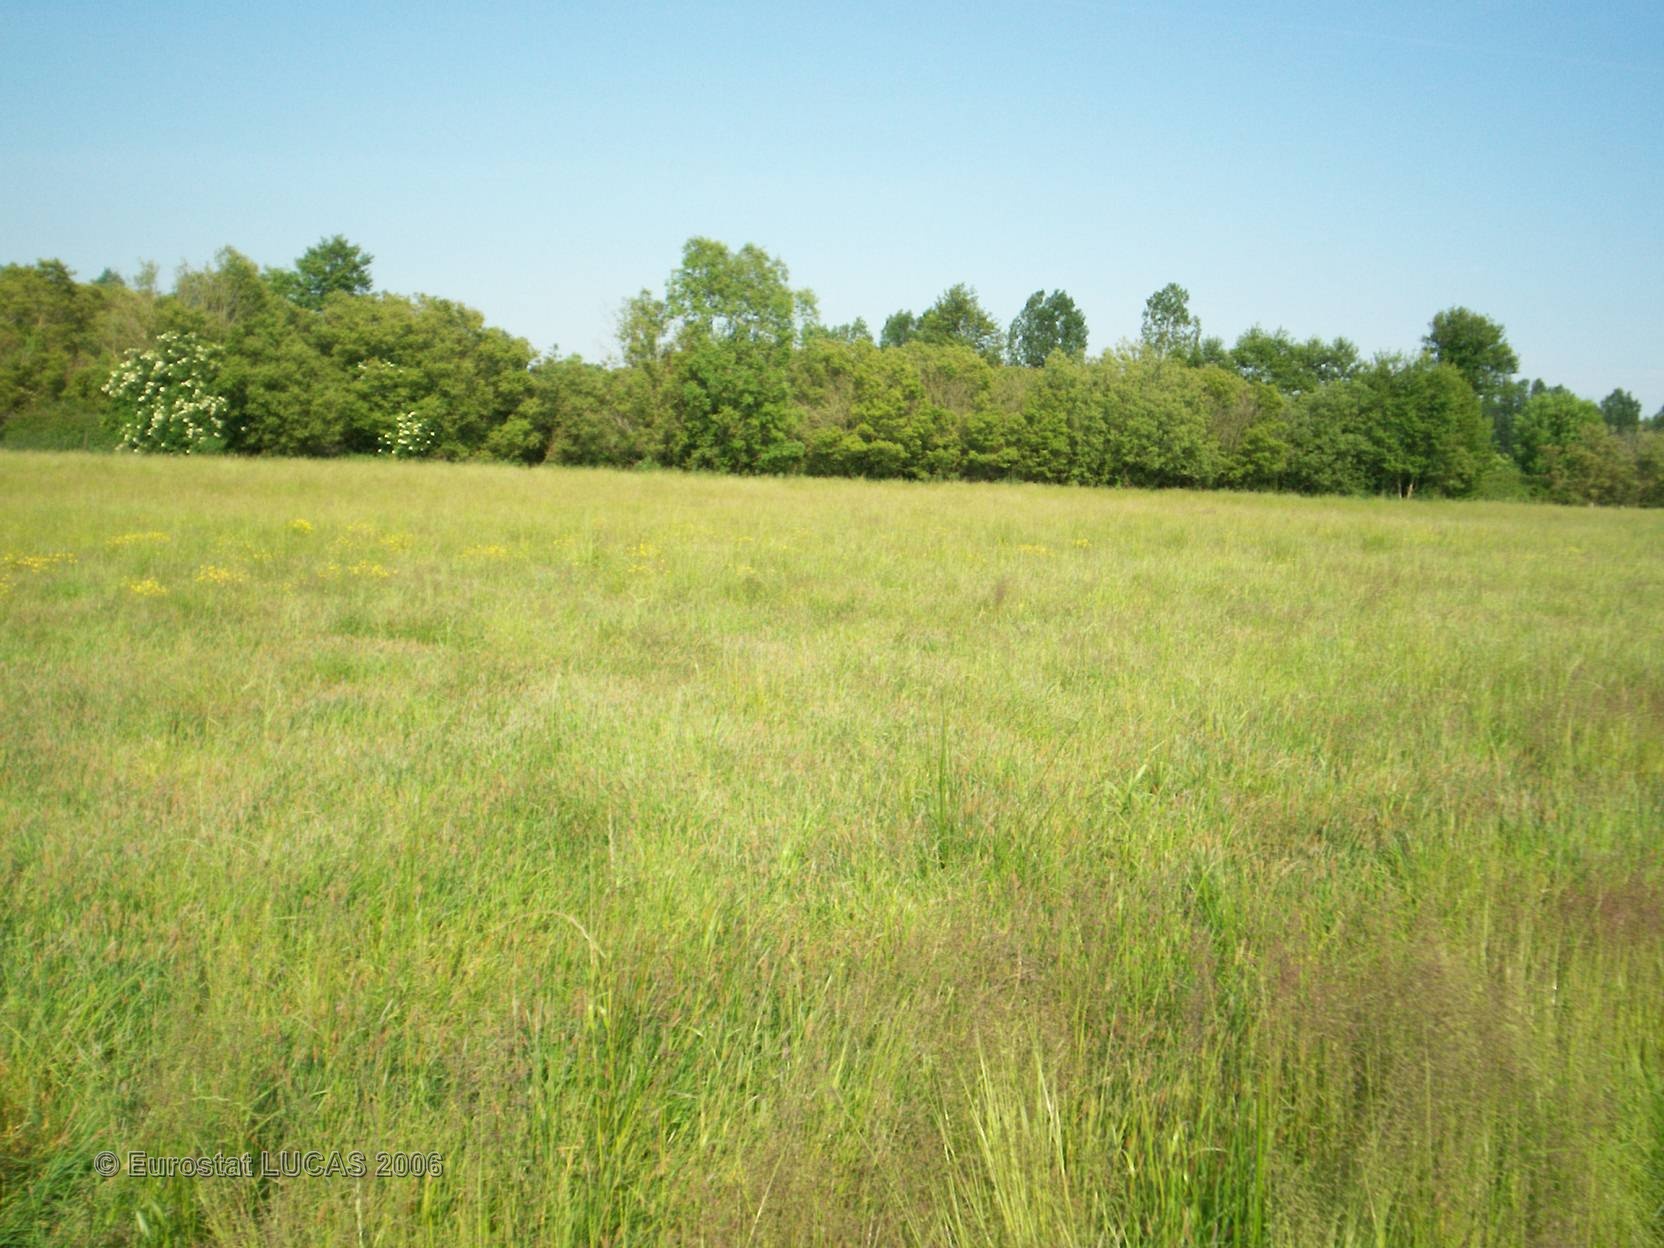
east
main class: Grassland
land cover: Grassland without tree/shrub cover
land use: Agriculture (excluding fallow land and kitchen gardens)
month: June
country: FR
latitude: 48.5421
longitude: -1.7123
